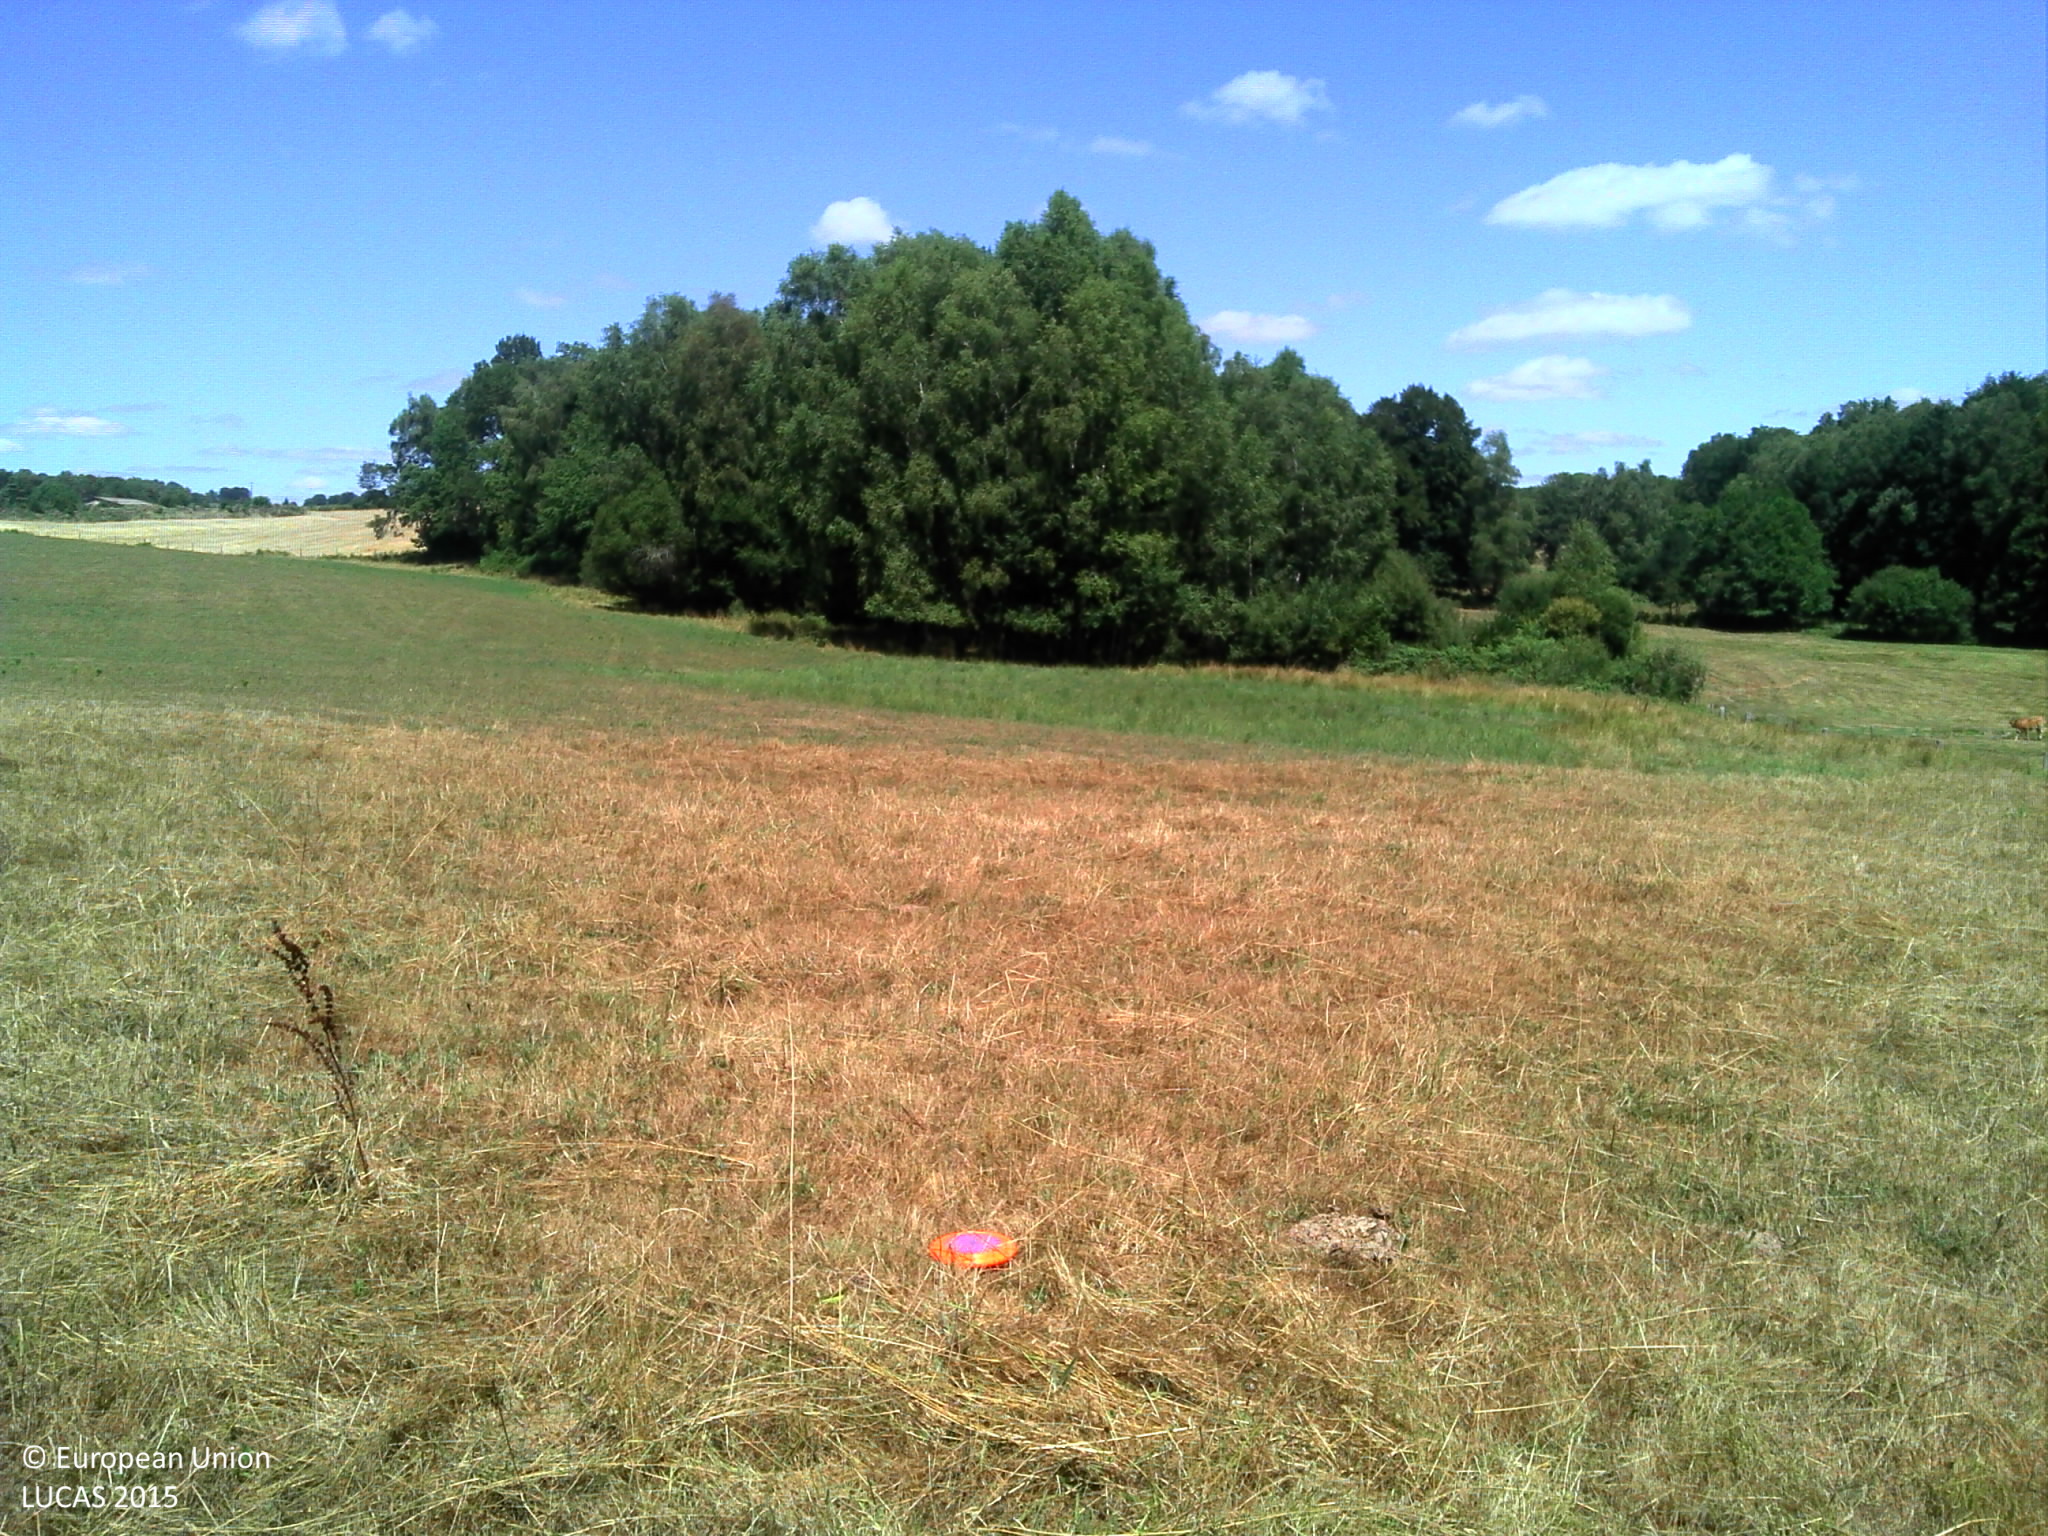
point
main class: Grassland
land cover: Grassland without tree/shrub cover
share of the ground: > 75 %
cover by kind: herbaceous plants 100 %
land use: Agriculture (excluding fallow land and kitchen gardens)
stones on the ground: < 10 %
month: July
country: FR
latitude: 45.5718
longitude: 1.6523
